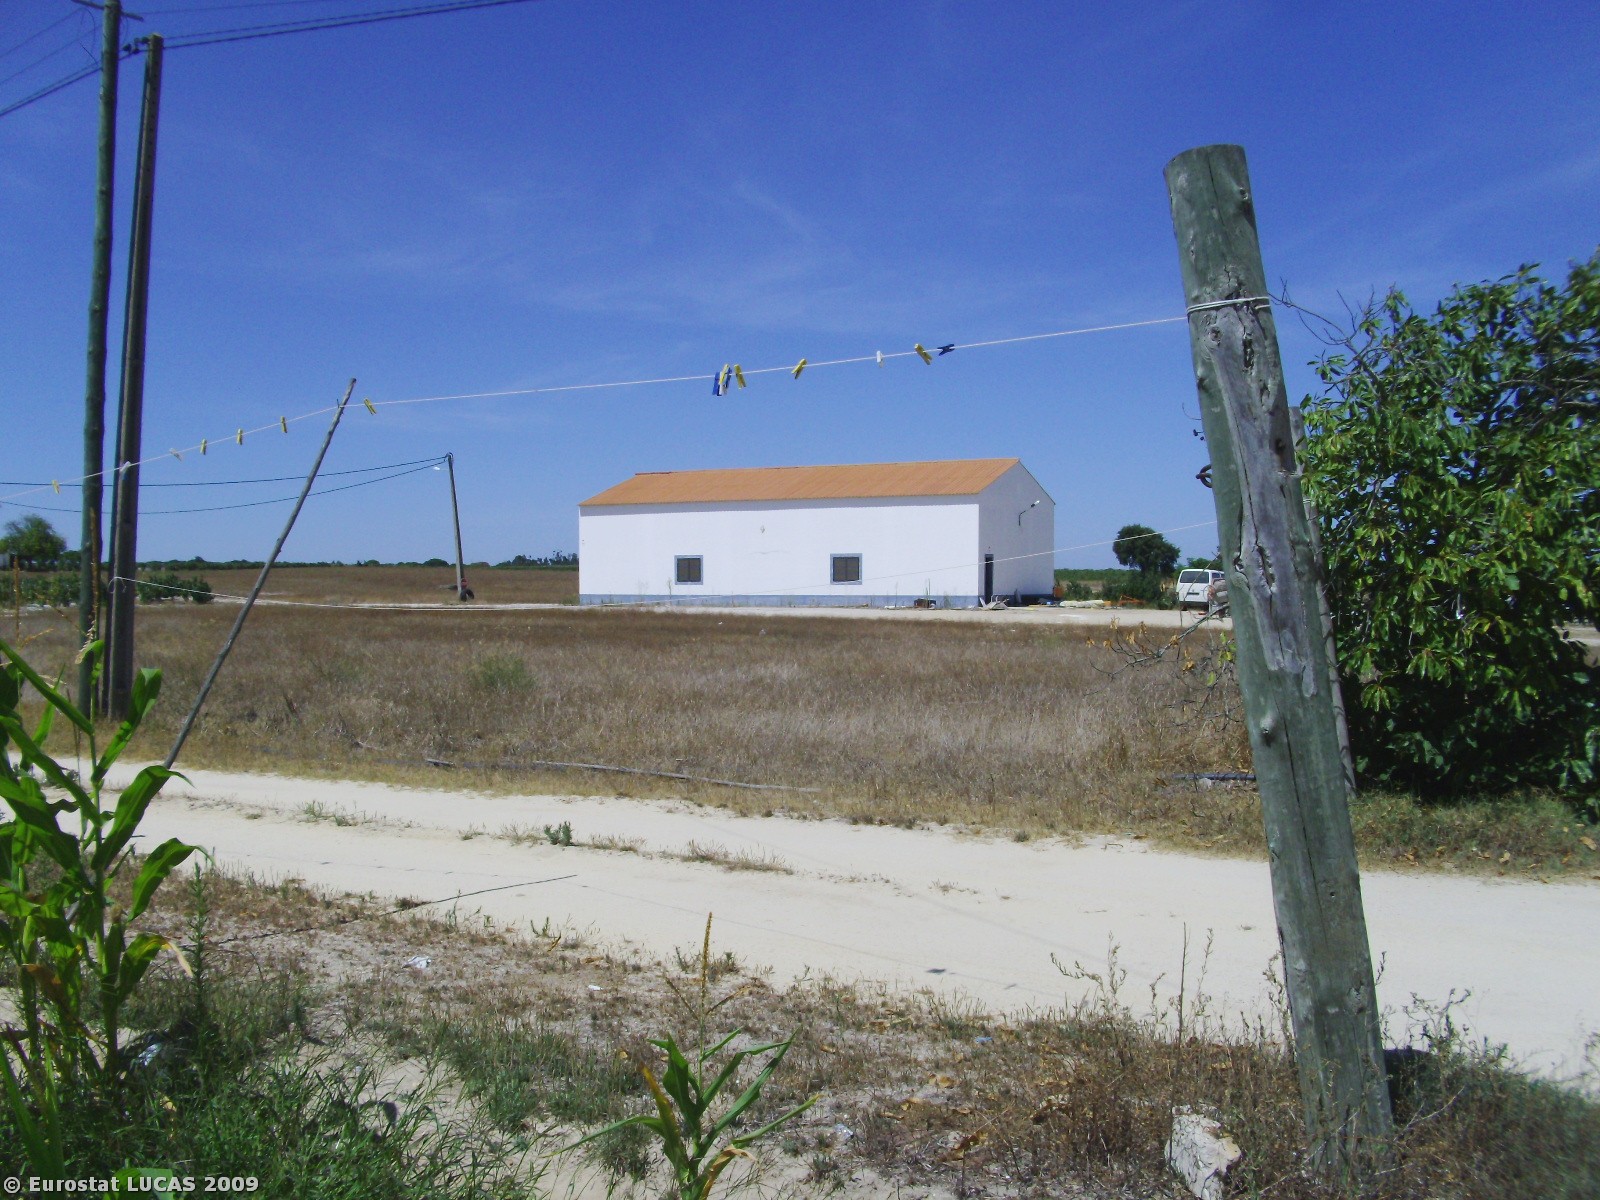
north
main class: Cropland
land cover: Maize
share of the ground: > 75 %
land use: Agriculture (excluding fallow land and kitchen gardens)
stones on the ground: 25 - 50 %
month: August
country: PT
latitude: 38.7052
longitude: -8.7263
